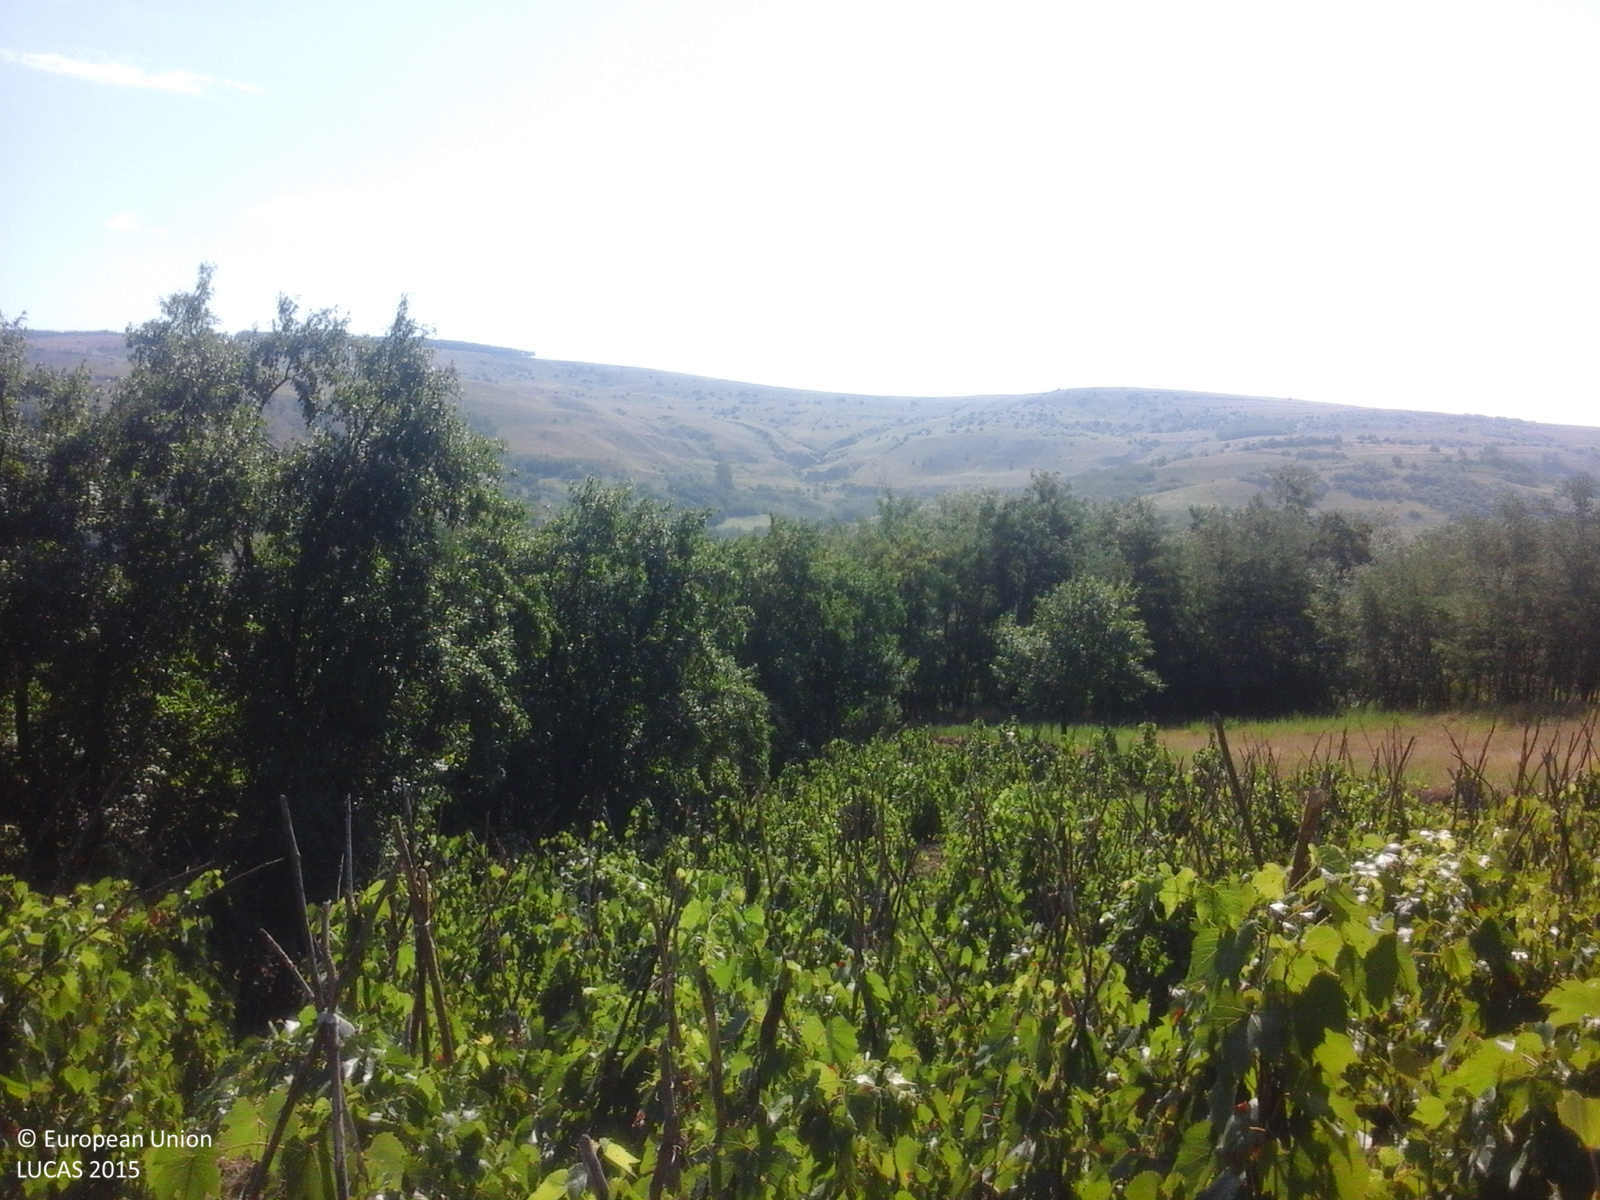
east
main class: Cropland
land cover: Vineyards
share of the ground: > 75 %
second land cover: Other bare soil
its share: > 75 %
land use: Agriculture (excluding fallow land and kitchen gardens)
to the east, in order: Vineyards; Other bare soil; Shrubland with sparse tree cover; Tracks; Broadleaved woodland; Shrubland with sparse tree cover; Vineyards
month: July
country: RO
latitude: 46.4373
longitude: 27.2973
